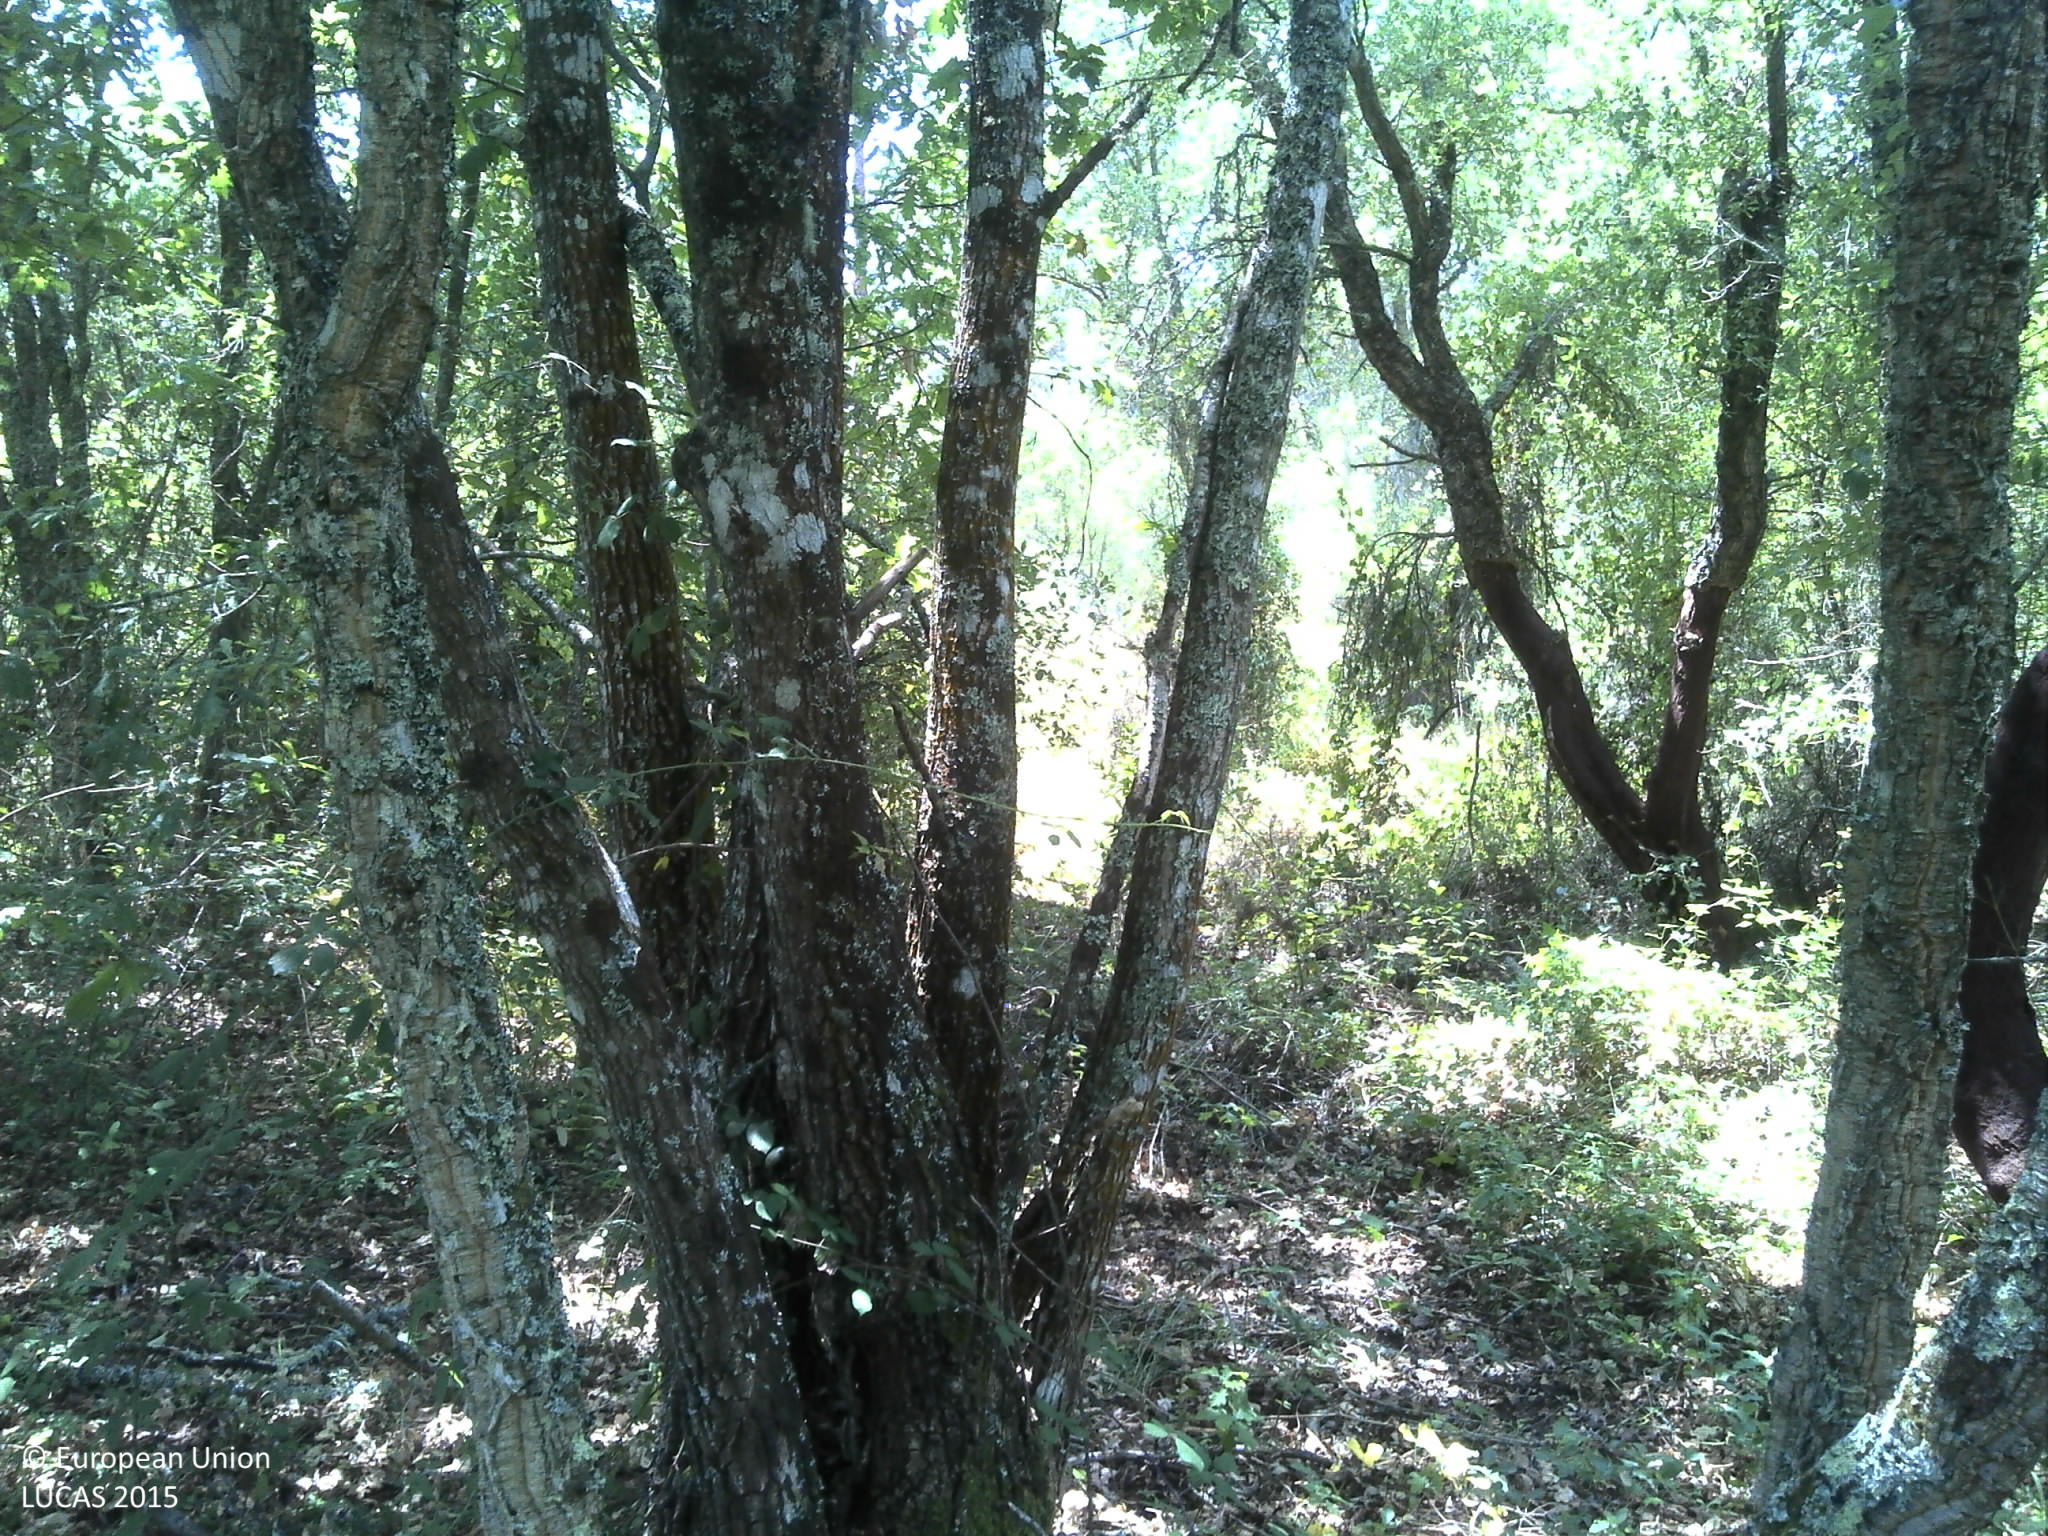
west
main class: Woodland
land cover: Broadleaved woodland
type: thermophilous deciduous forest
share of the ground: 50 - 75 %
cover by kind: broadleaved forest trees 75 %, unconsolidated bare surface 15 %, shrubs 10 %
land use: Semi-natural and natural areas not in use
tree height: > 5 m
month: July
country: PT
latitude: 40.2244
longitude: -8.2350
